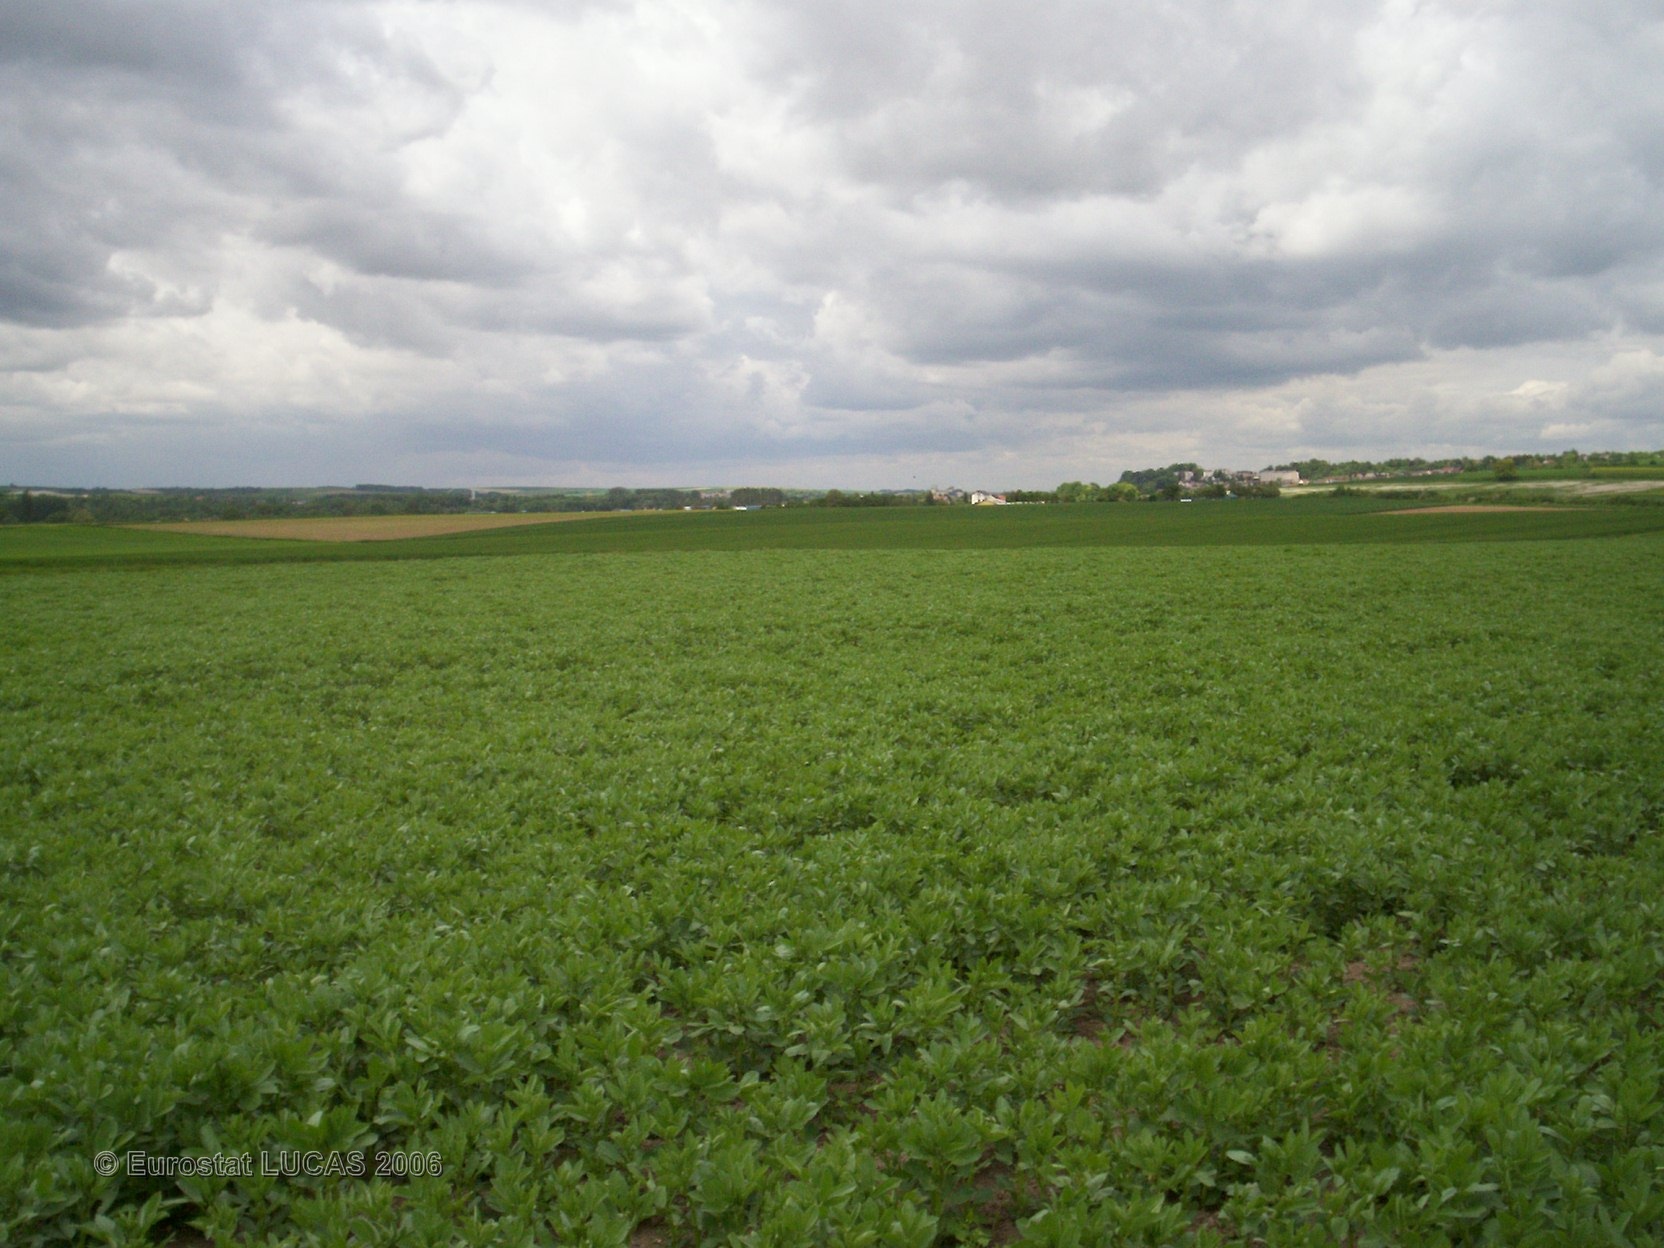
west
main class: Cropland
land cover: Dry pulses
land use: Agriculture (excluding fallow land and kitchen gardens)
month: May
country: FR
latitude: 49.5060
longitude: 4.4031
